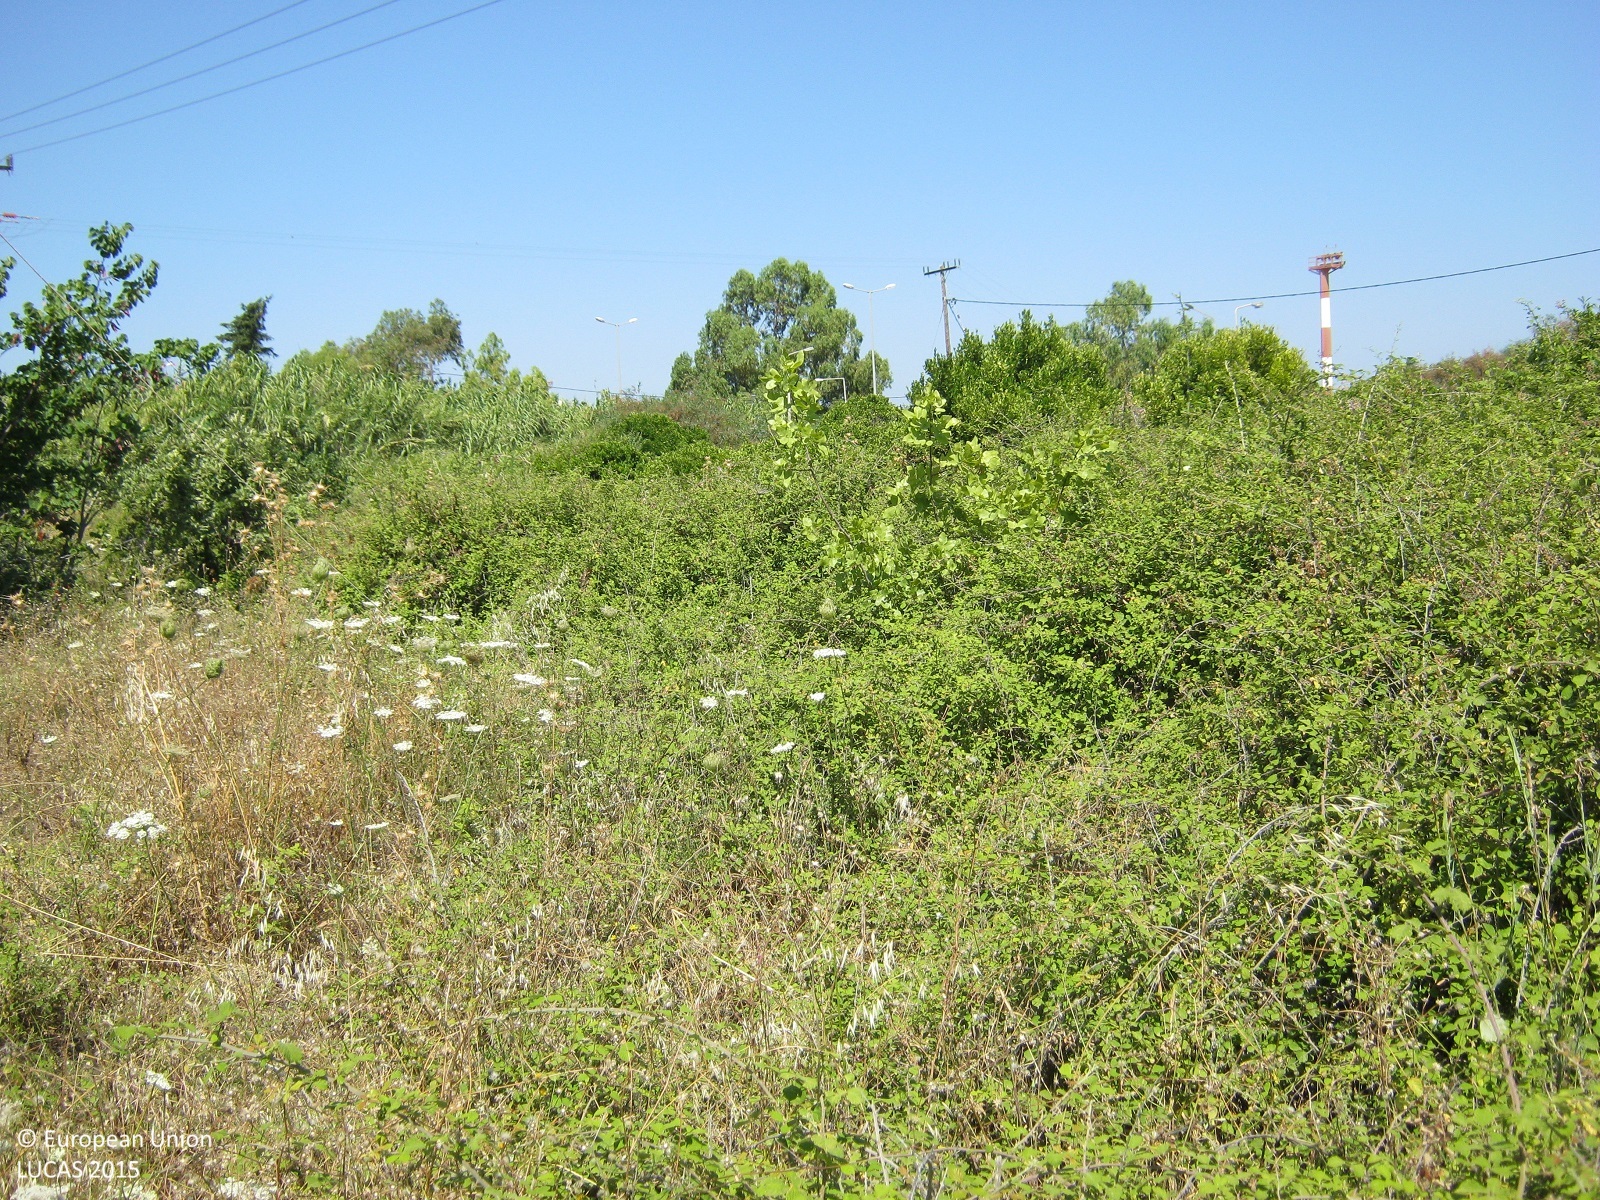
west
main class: Shrubland
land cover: Shrubland without tree cover
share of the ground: > 75 %
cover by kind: shrubs 90 %, herbaceous plants 10 %
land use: Semi-natural and natural areas not in use
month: June
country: GR
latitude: 36.4034
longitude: 28.0959
